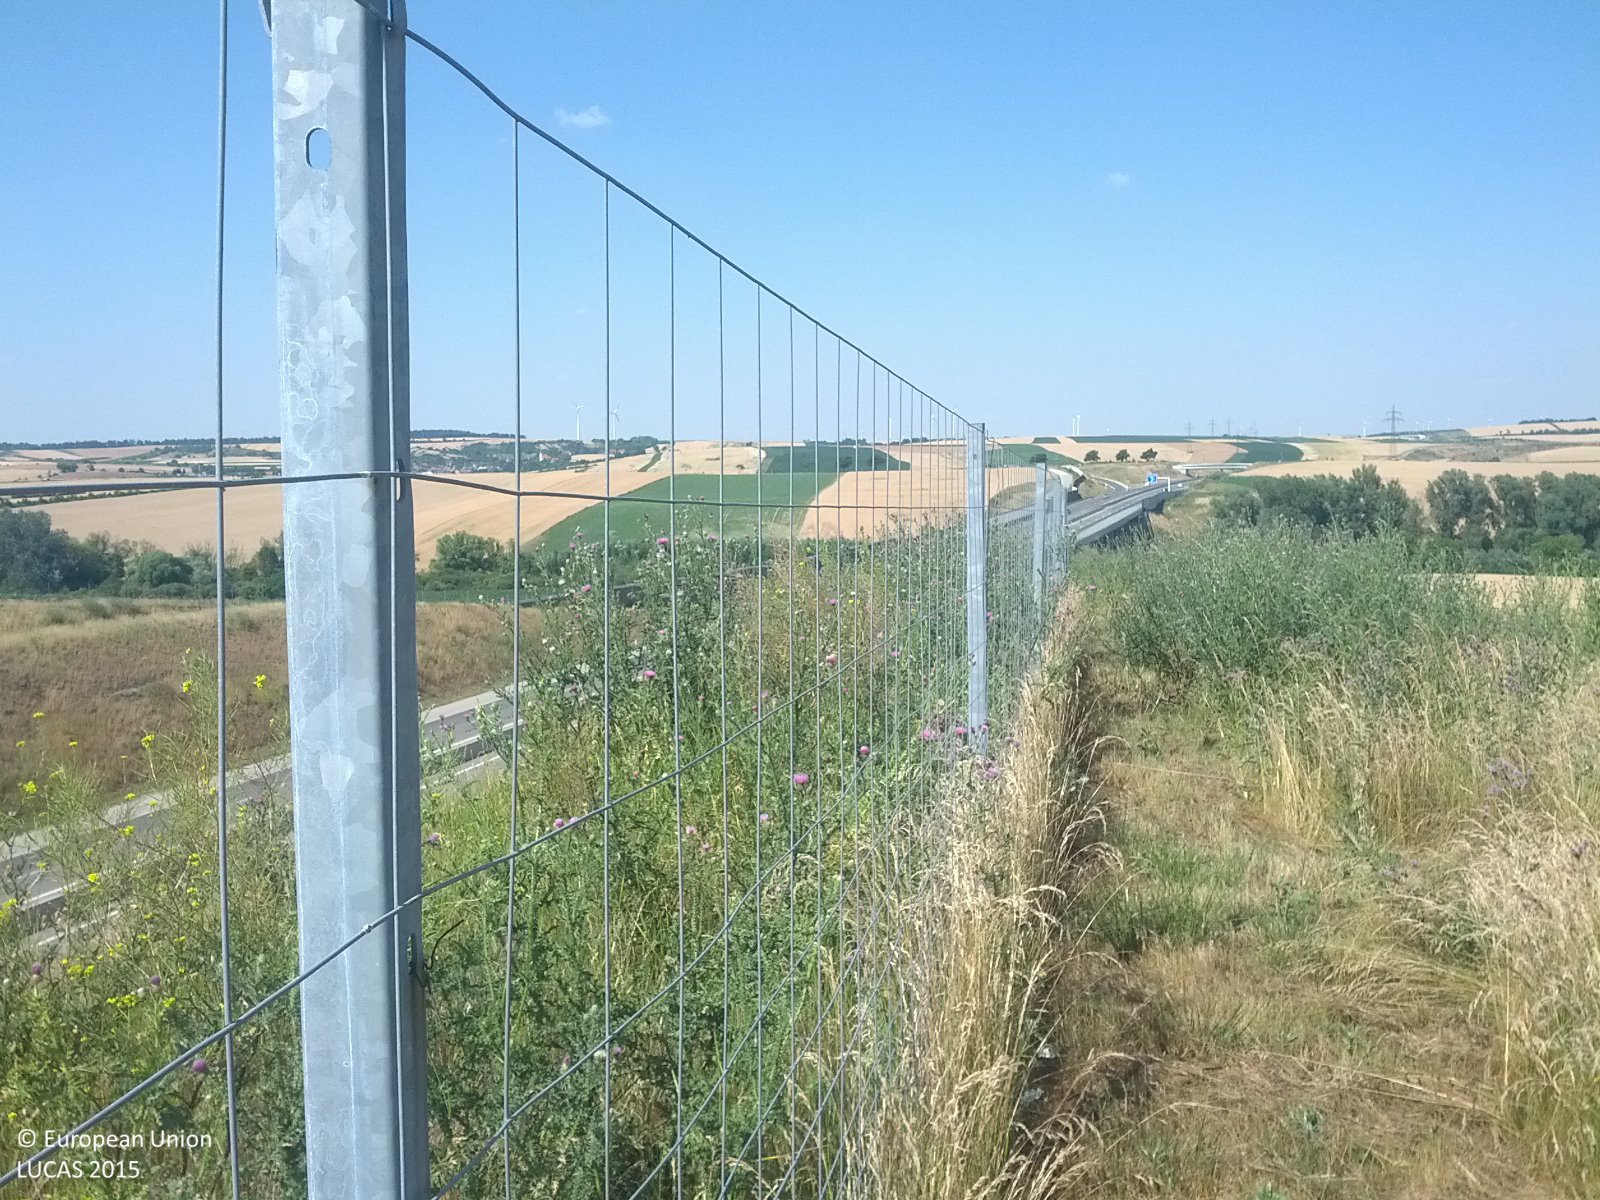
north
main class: Grassland
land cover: Grassland without tree/shrub cover
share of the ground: > 75 %
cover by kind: herbaceous plants 100 %
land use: Road transport
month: July
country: AT
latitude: 48.4790
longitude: 16.5674
